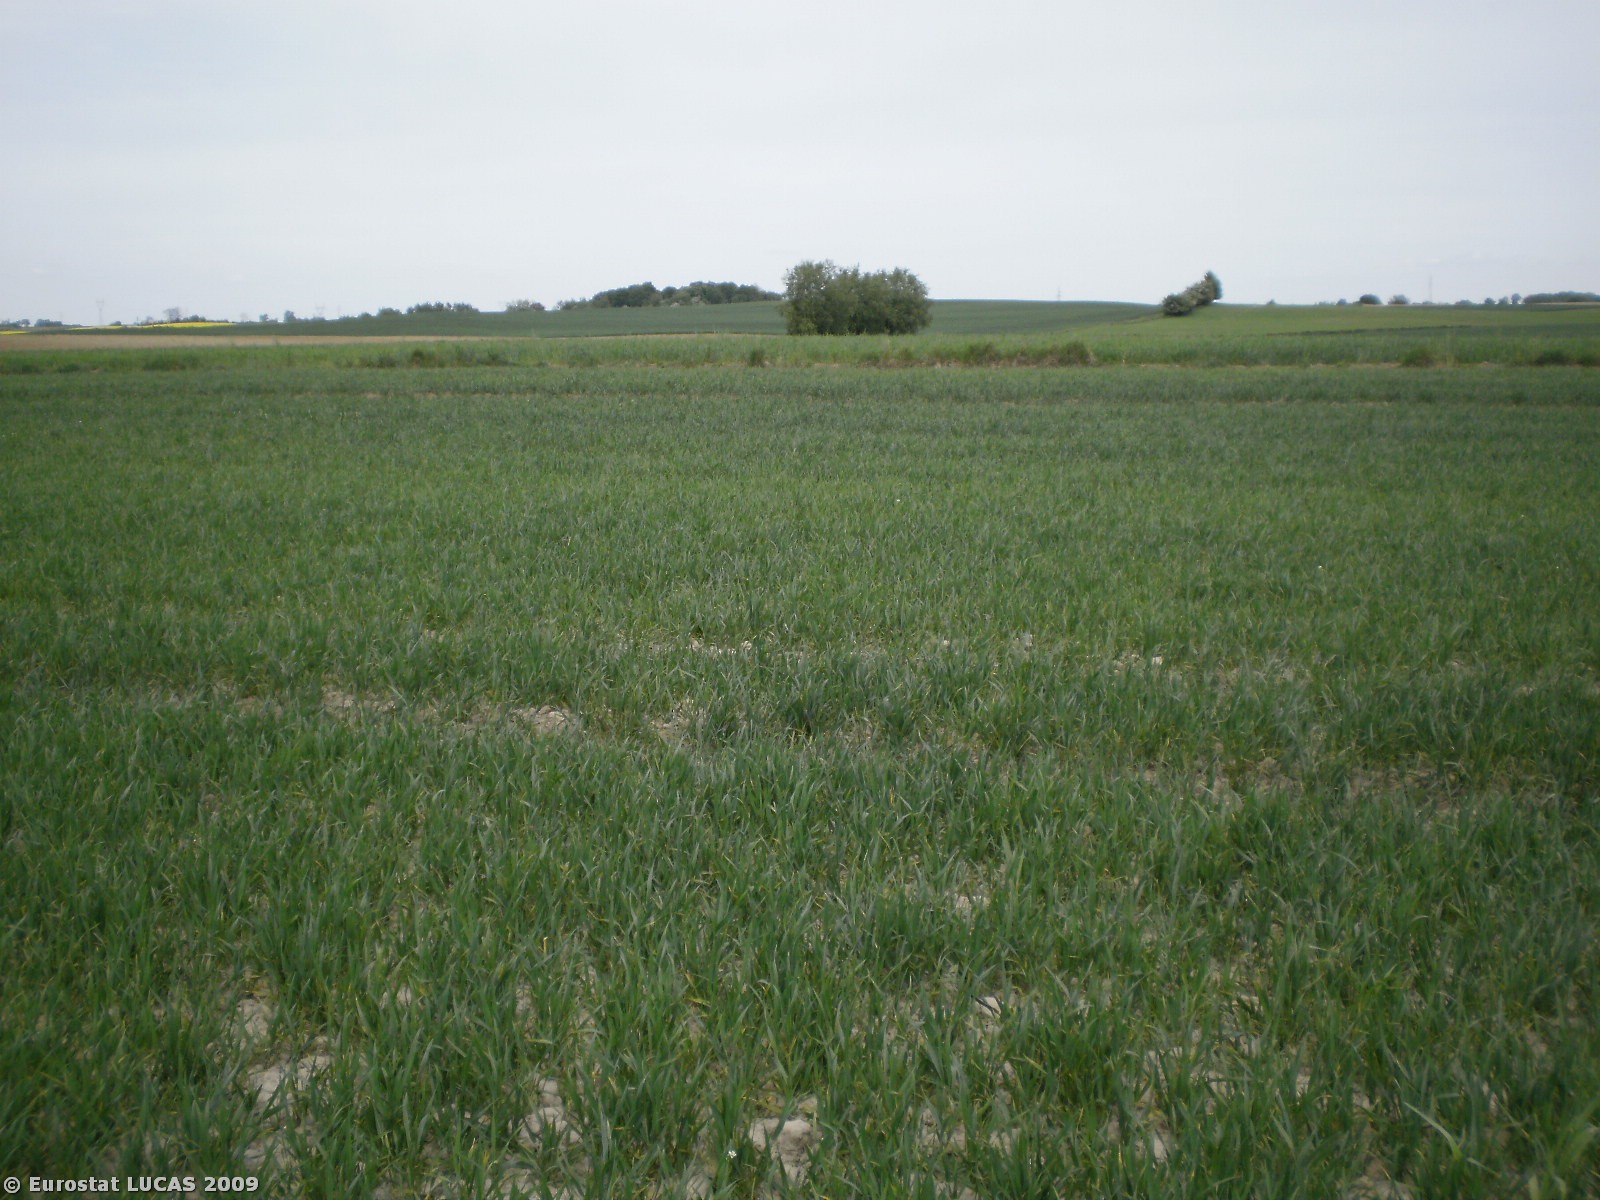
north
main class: Cropland
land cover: Common wheat
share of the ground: 50 - 75 %
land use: Agriculture (excluding fallow land and kitchen gardens)
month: May
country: PL
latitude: 53.2983
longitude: 18.7983
